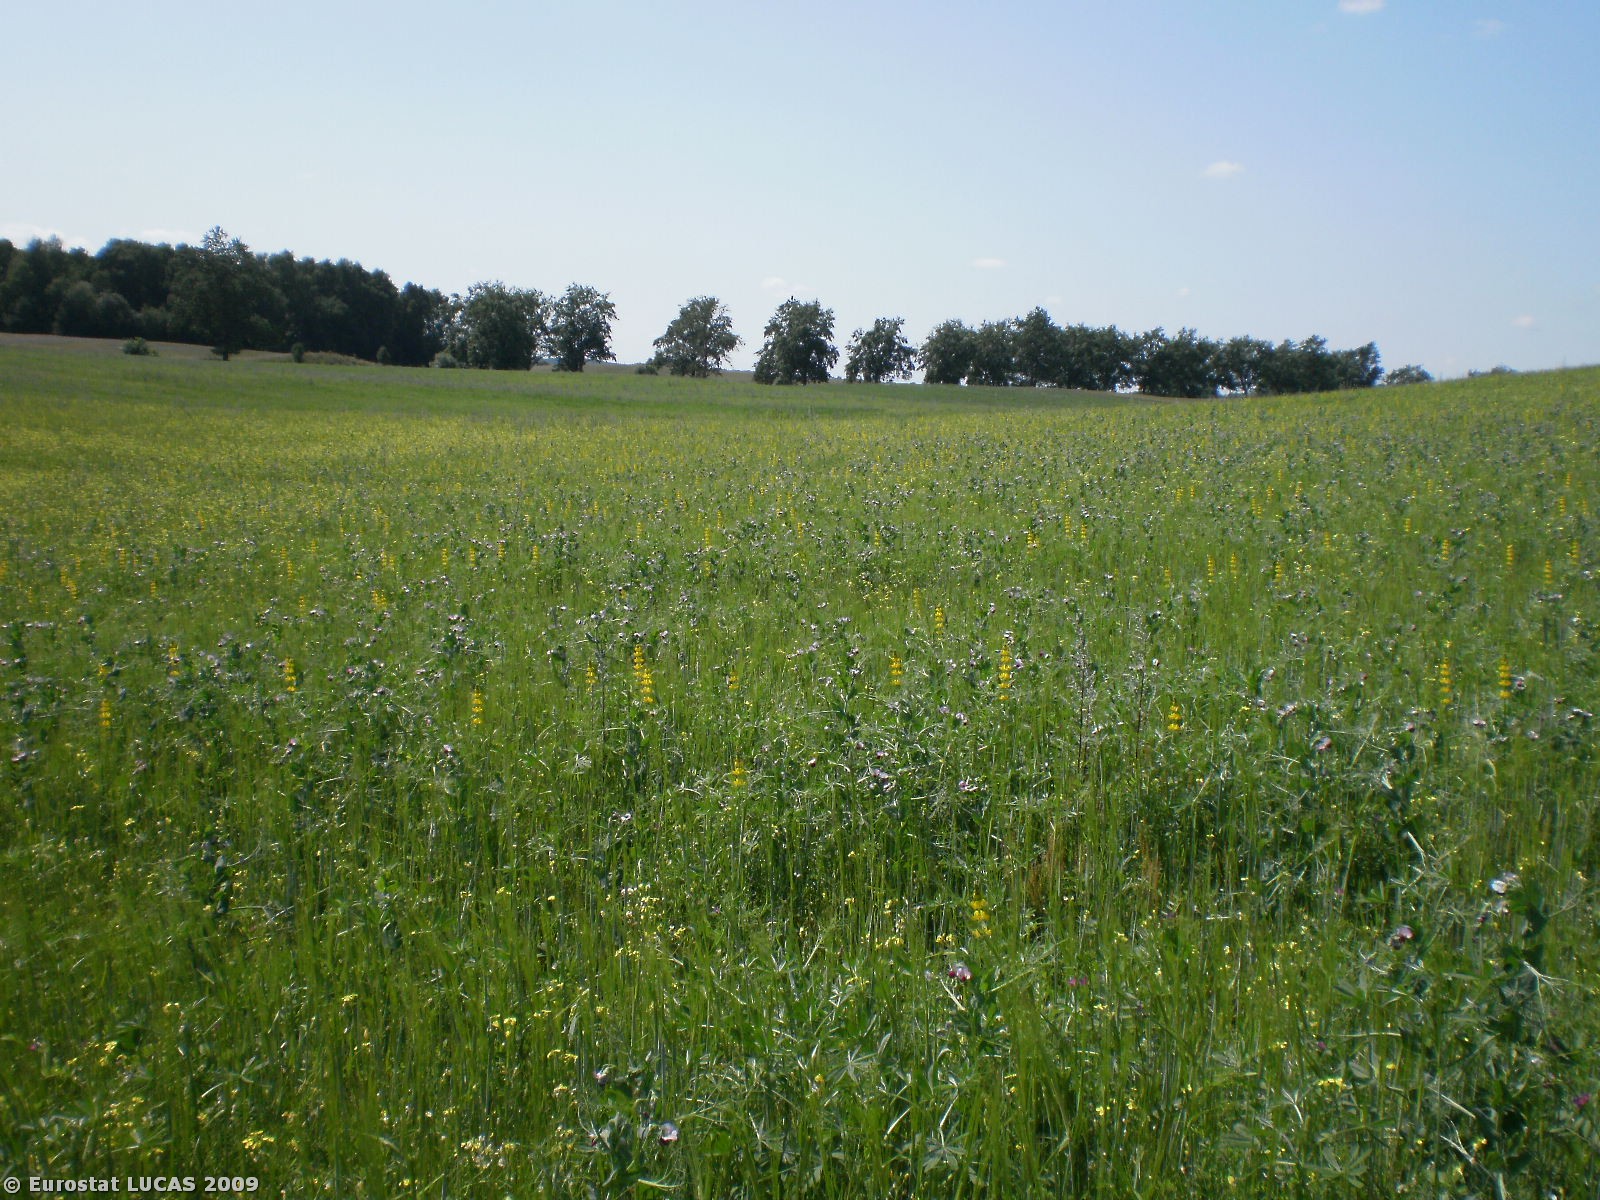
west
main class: Cropland
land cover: Mixed cereals for fodder
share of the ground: > 75 %
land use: Agriculture (excluding fallow land and kitchen gardens)
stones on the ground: < 10 %
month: February
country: PL
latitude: 54.1412
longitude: 17.2501
